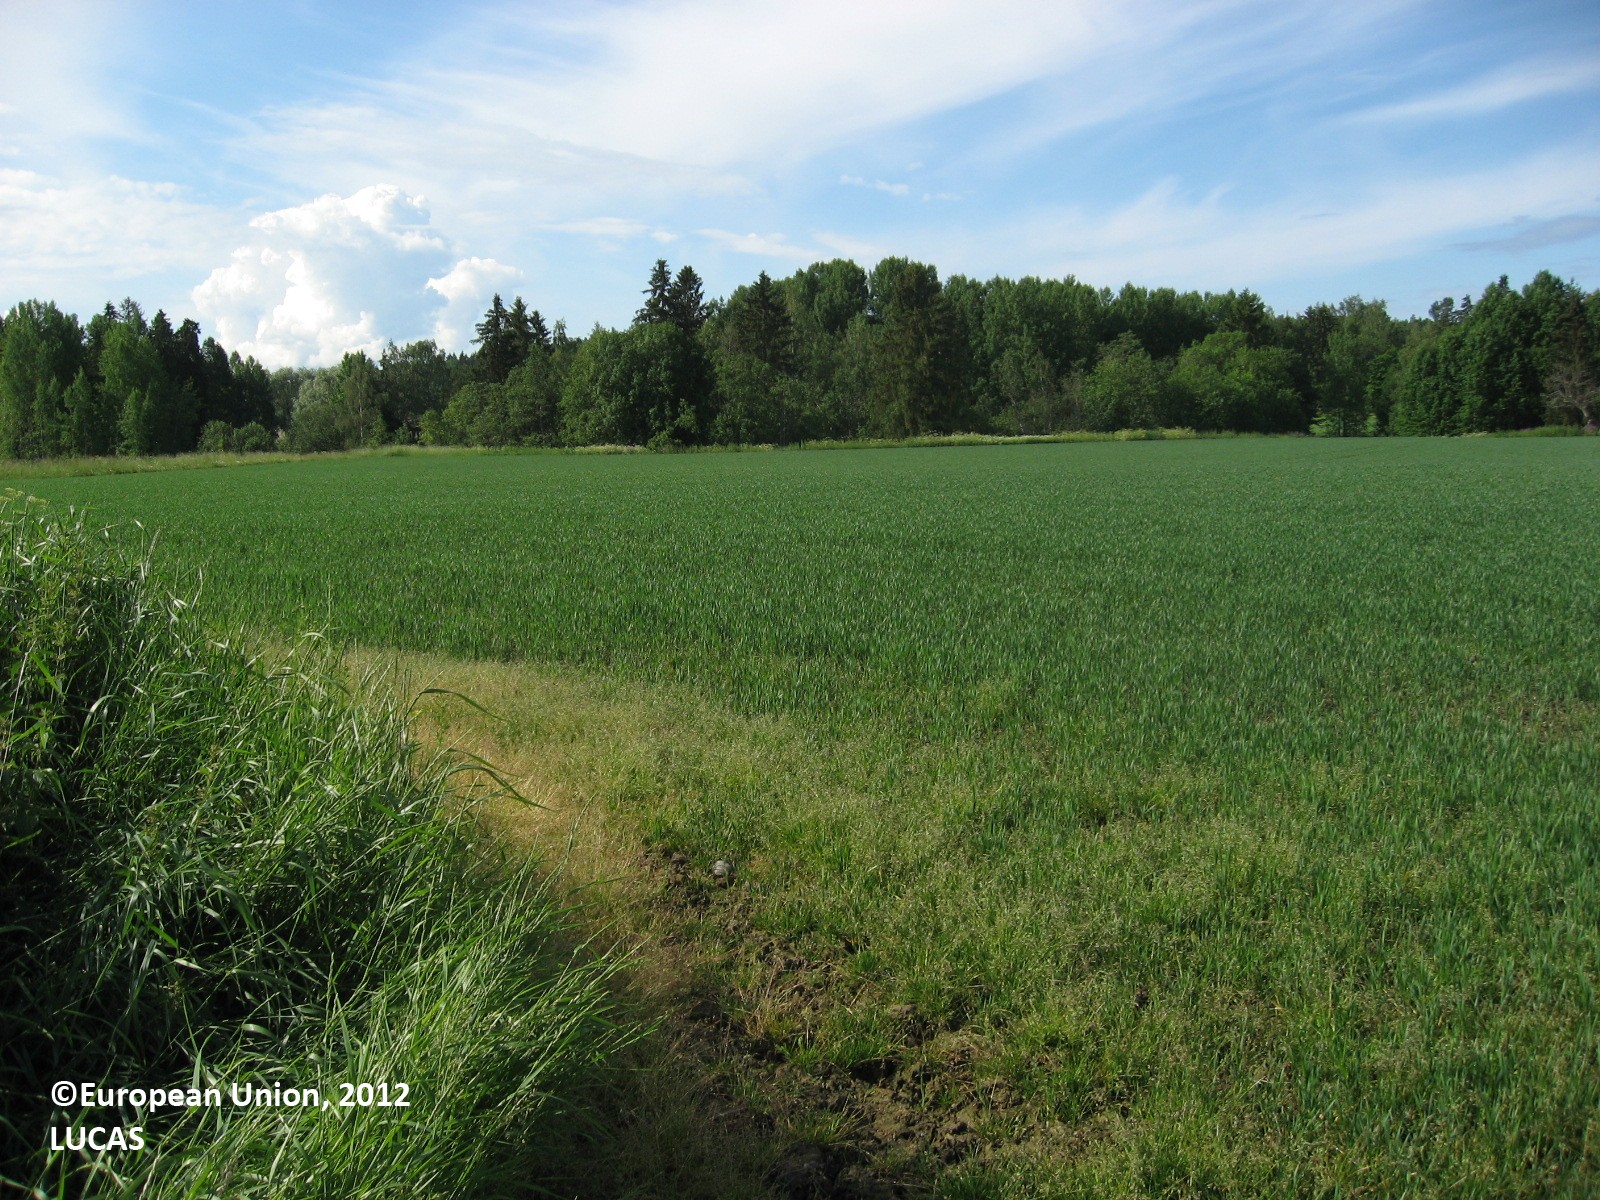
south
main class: Cropland
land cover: Common wheat
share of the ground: 50 - 75 %
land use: Agriculture (excluding fallow land and kitchen gardens)
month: June
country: FI
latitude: 60.6908
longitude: 26.2069
